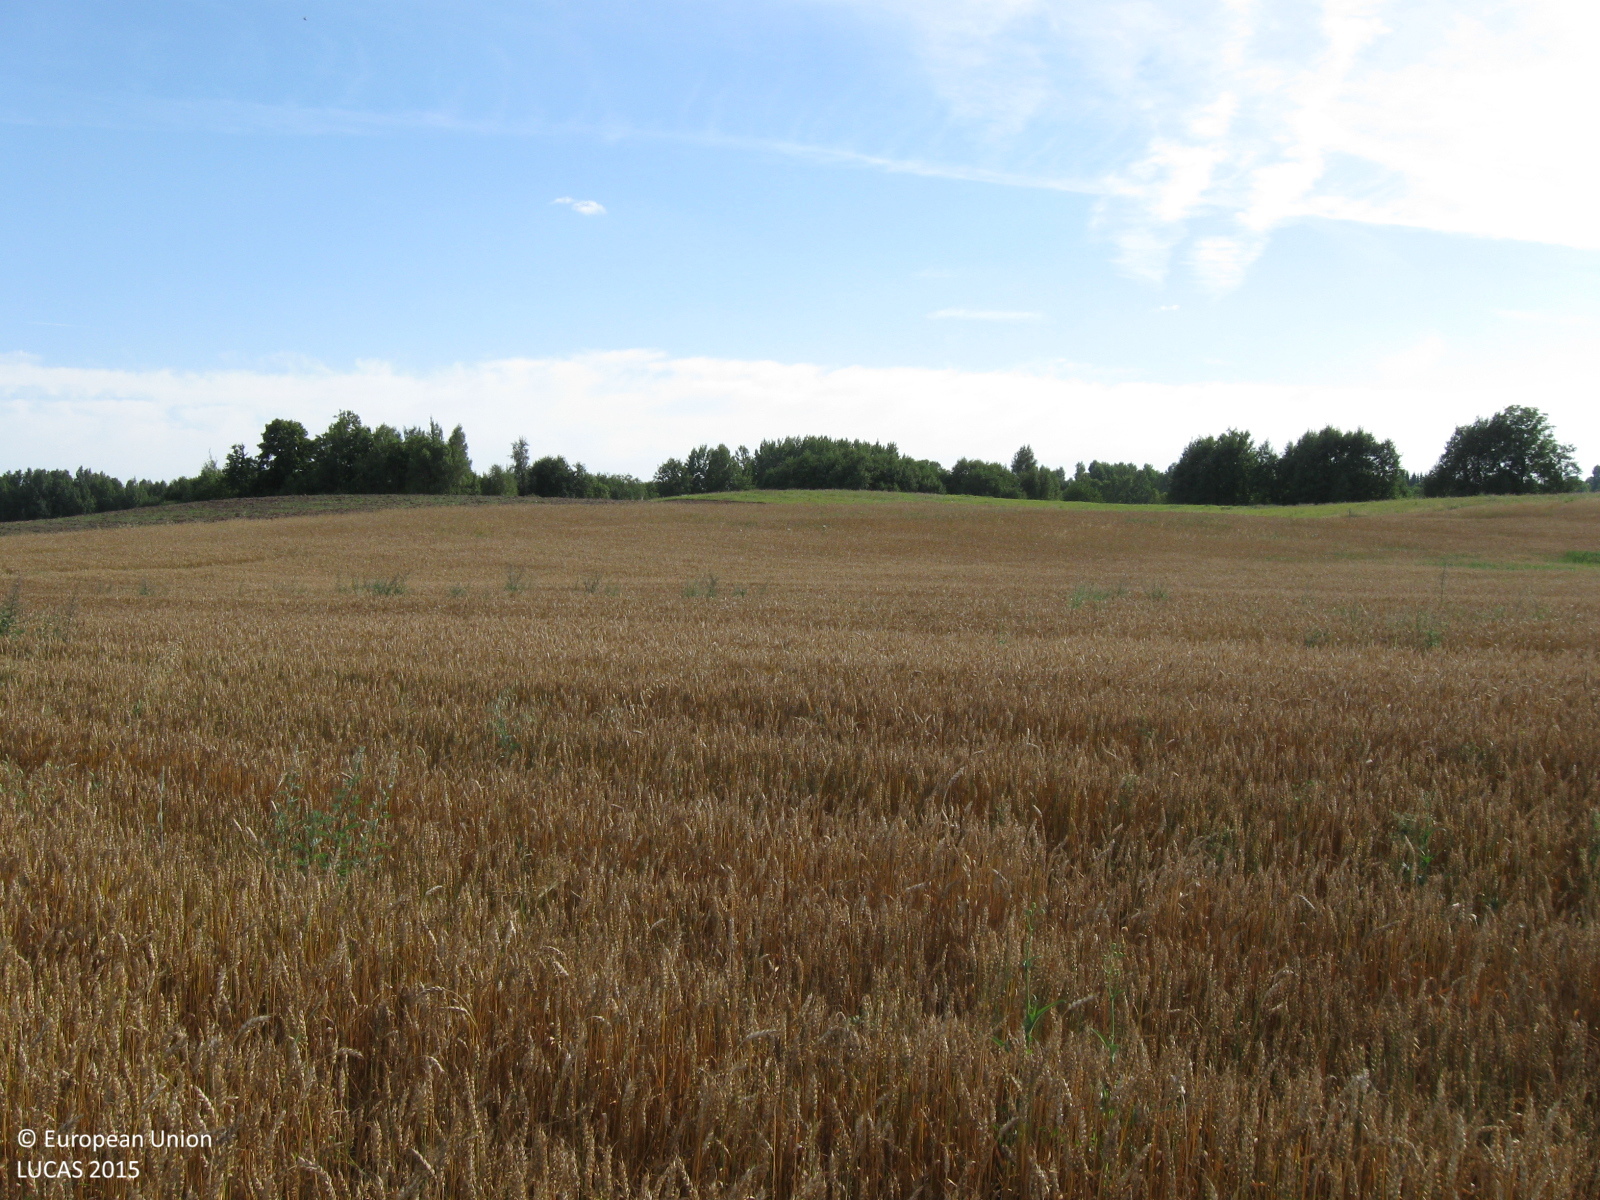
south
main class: Cropland
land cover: Common wheat
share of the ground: > 75 %
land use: Agriculture (excluding fallow land and kitchen gardens)
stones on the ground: < 10 %
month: August
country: LT
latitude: 55.4956
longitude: 22.5509
